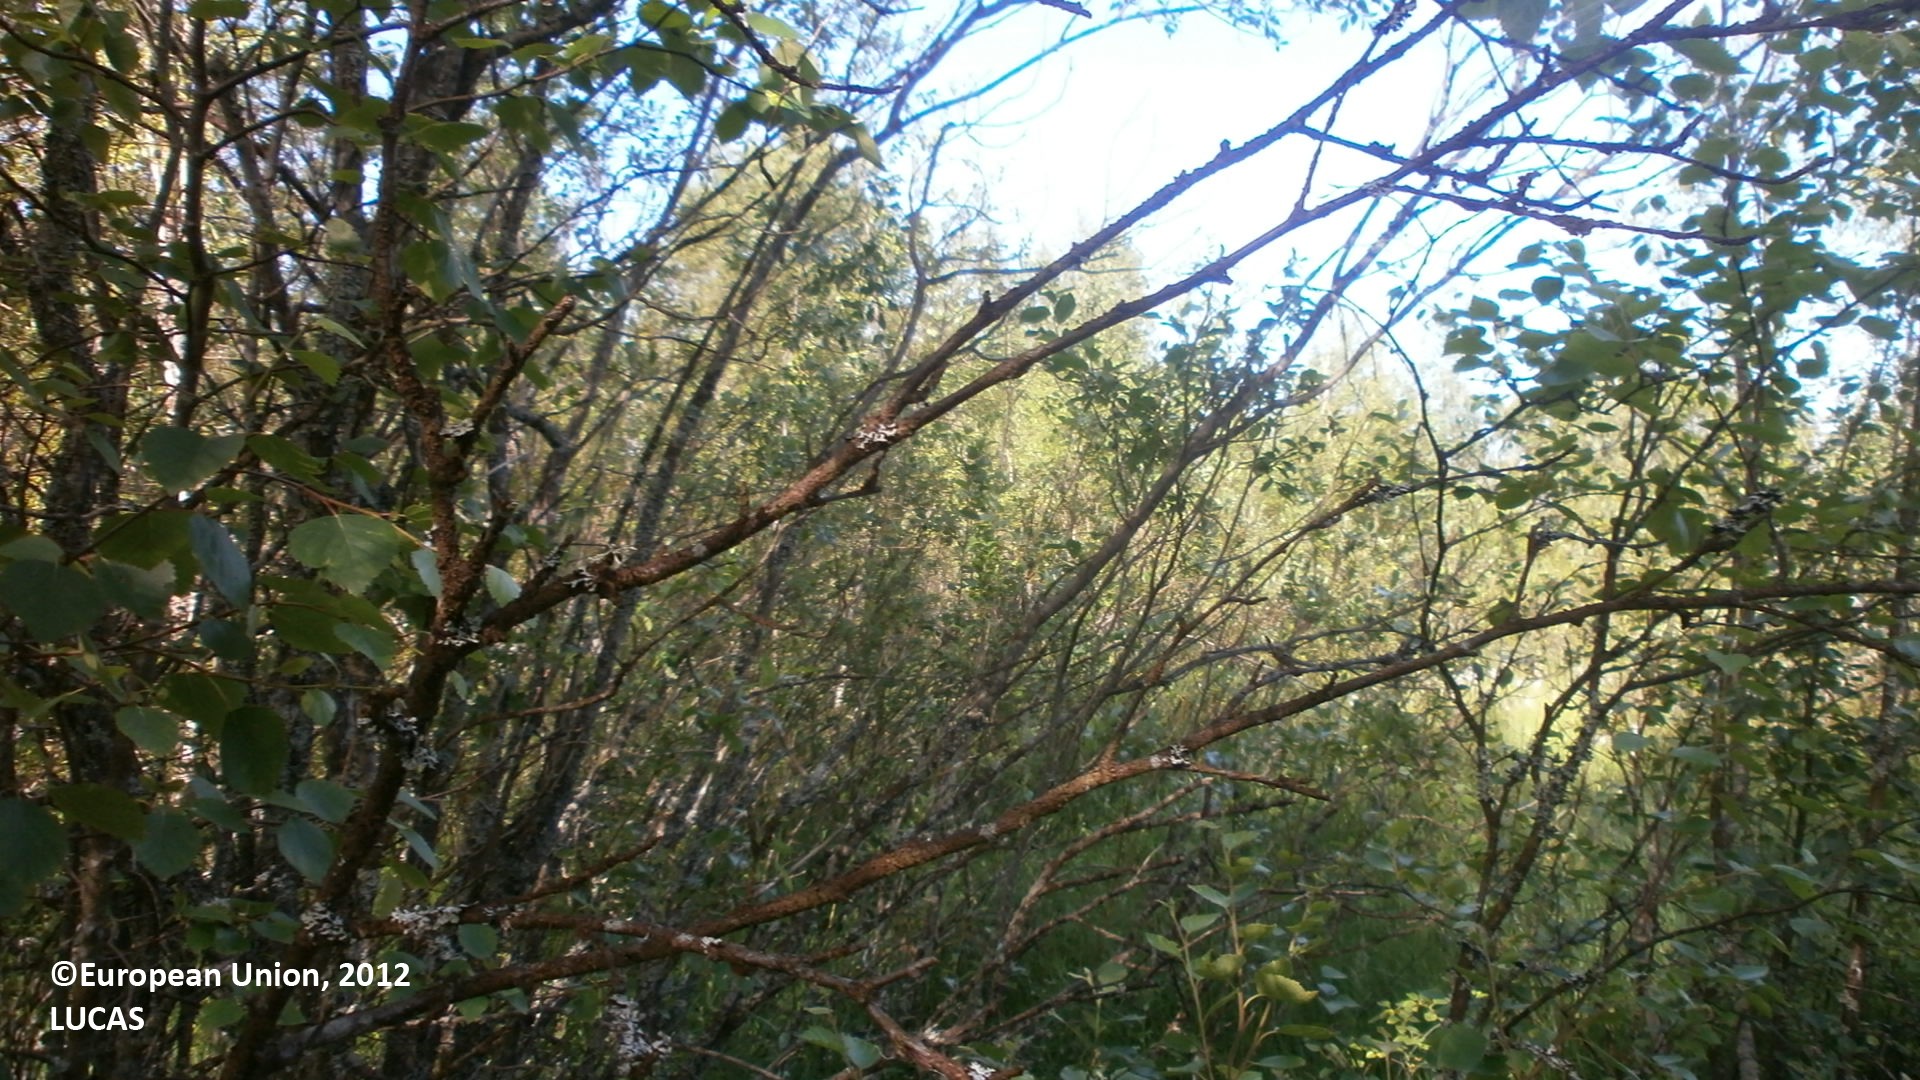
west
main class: Woodland
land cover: Broadleaved woodland
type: boreal forest
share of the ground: > 75 %
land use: Forestry
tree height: > 5 m
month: July
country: FI
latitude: 64.4256
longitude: 24.1189
